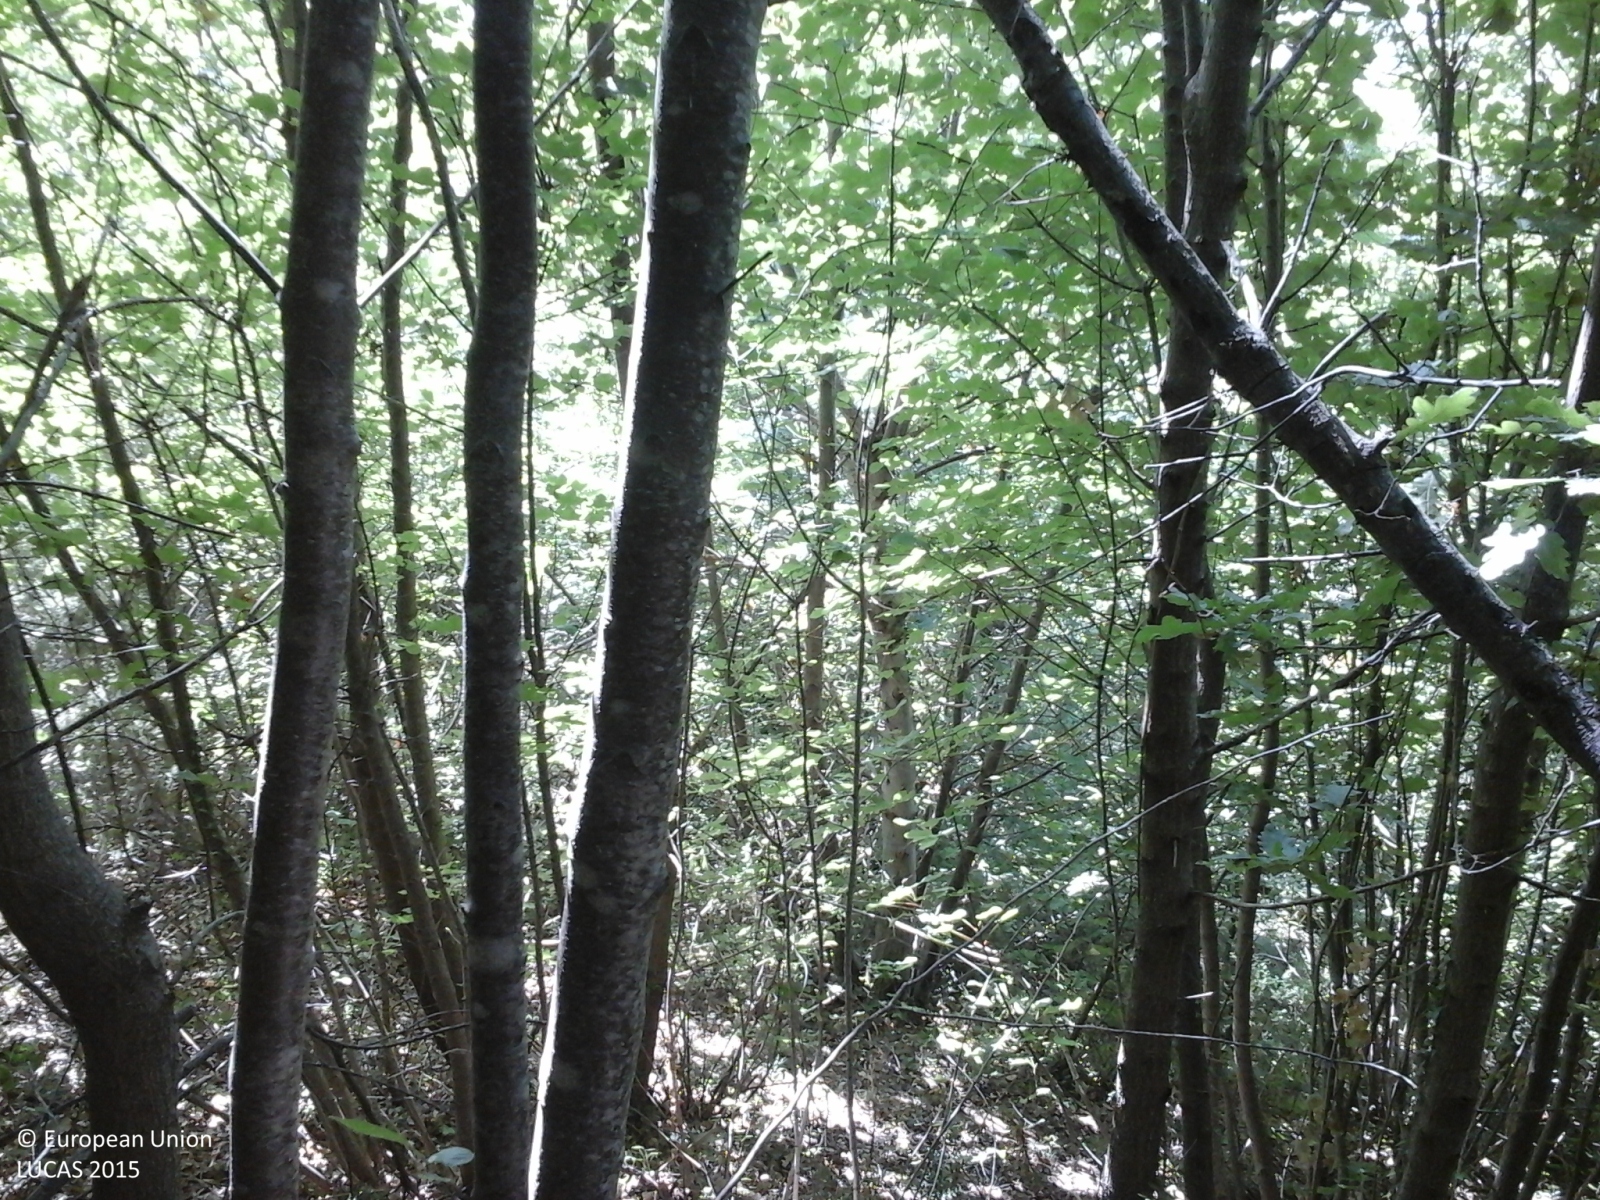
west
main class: Woodland
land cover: Broadleaved woodland
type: thermophilous deciduous forest
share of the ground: 50 - 75 %
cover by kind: broadleaved forest trees 100 %
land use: Forestry
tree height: > 5 m
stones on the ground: 10 - 25 %
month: August
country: IT
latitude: 42.7130
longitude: 11.6430
